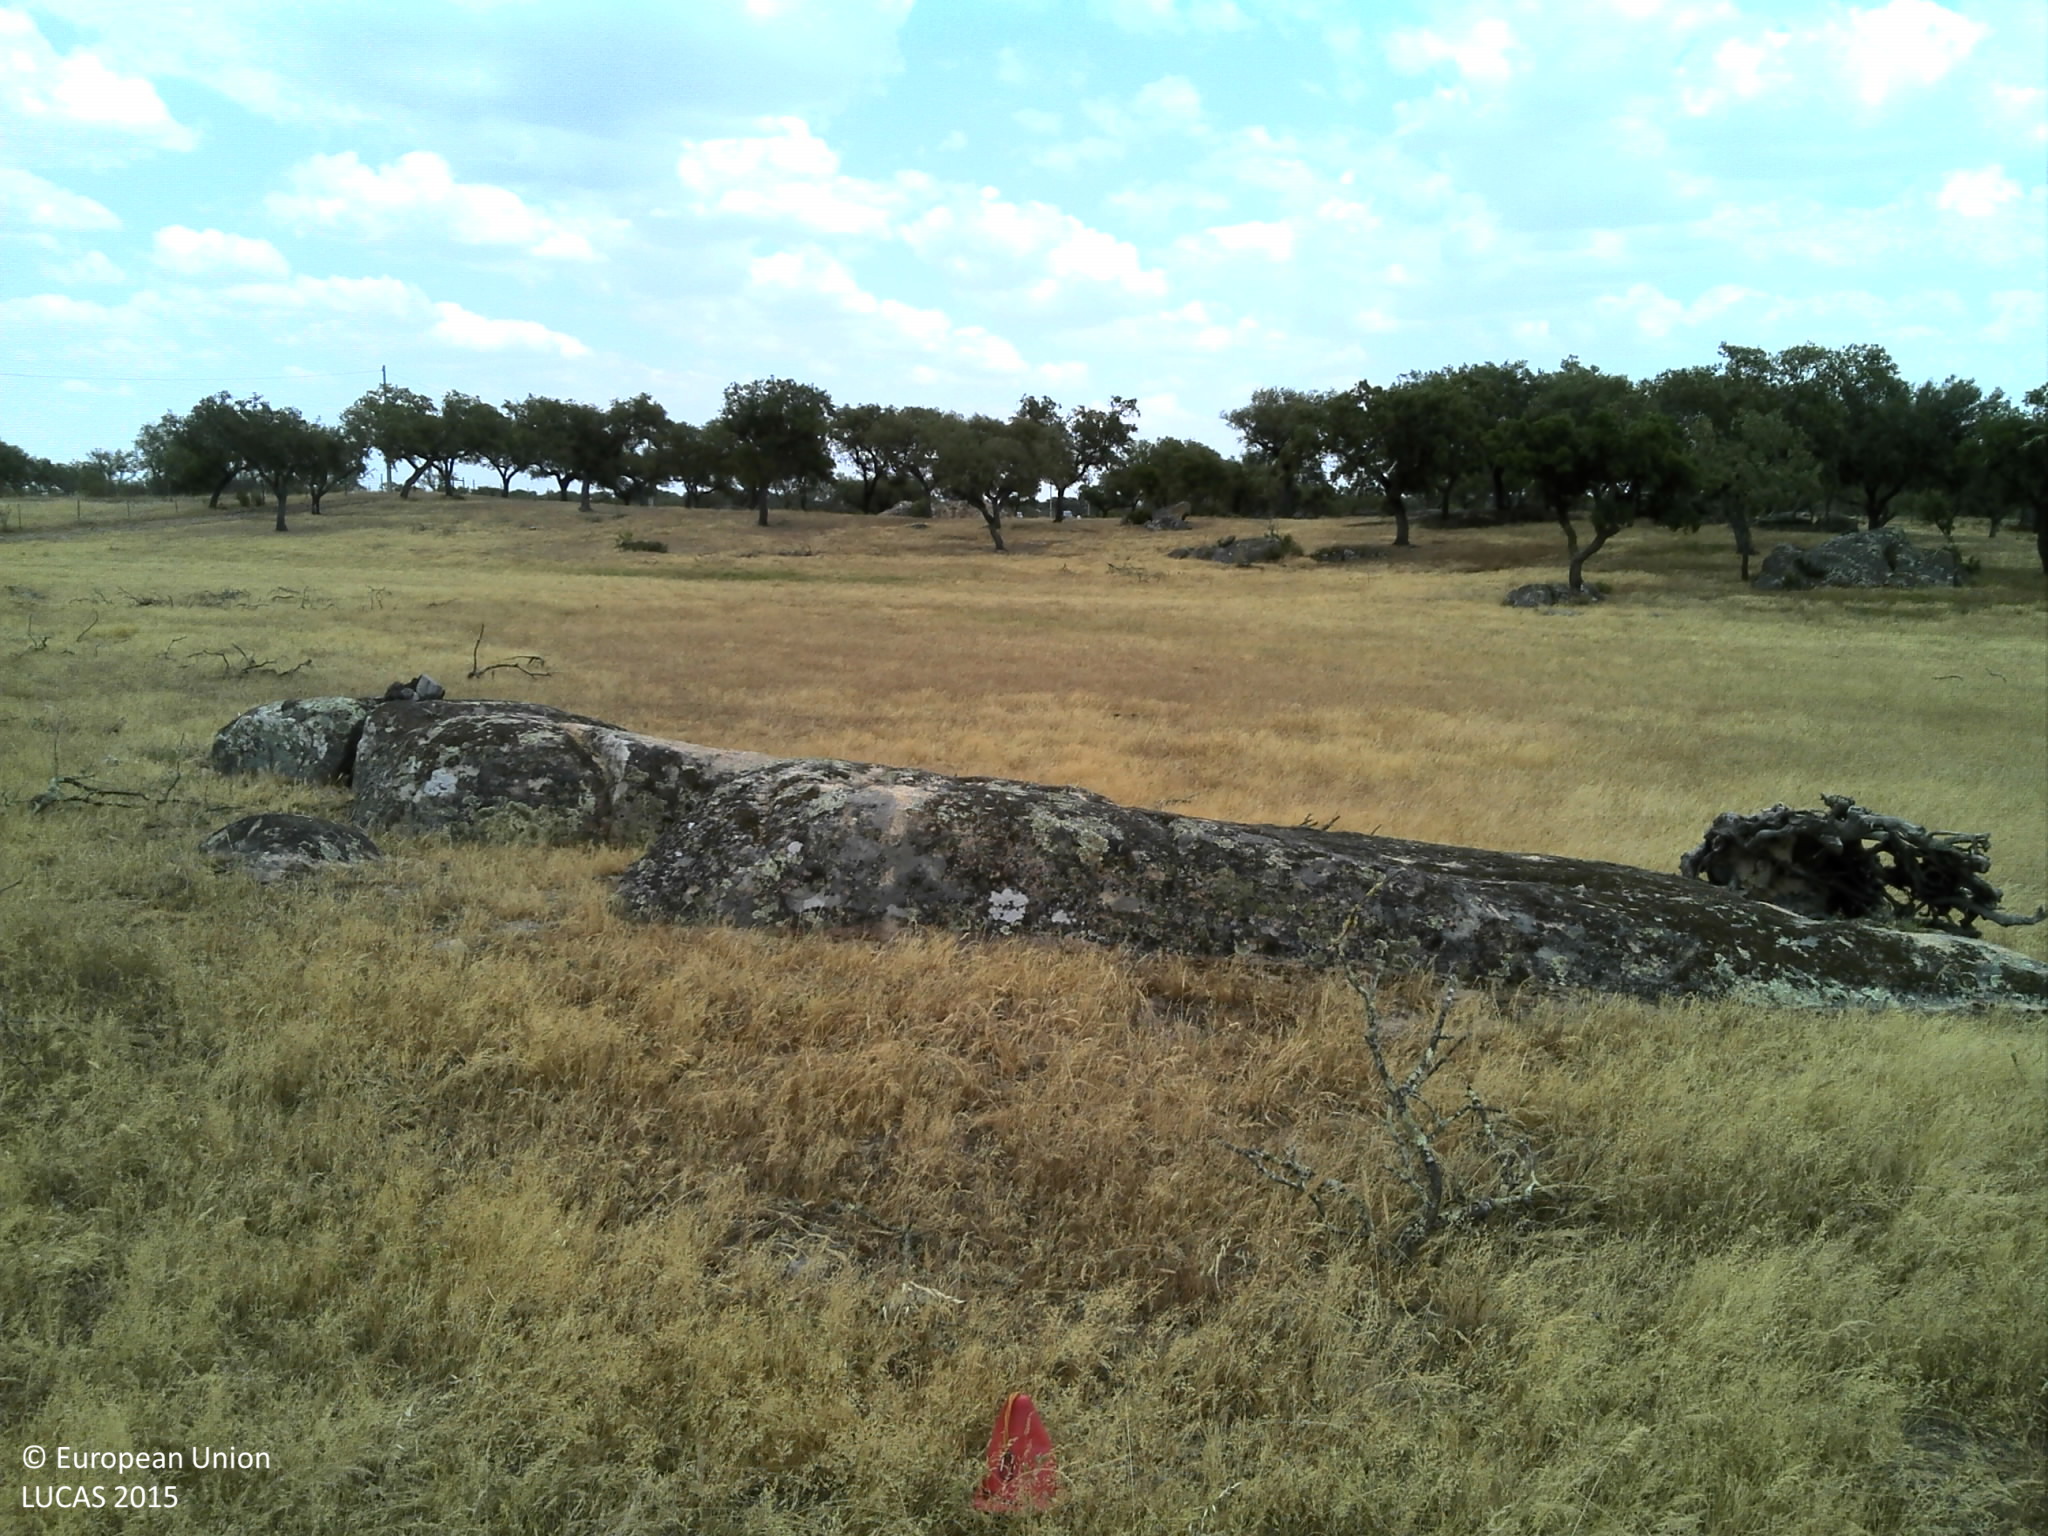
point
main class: Woodland
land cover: Broadleaved woodland
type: broadleaved evergreen forest
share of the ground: 10 - 25 %
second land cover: Grassland without tree/shrub cover
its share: 25 - 50 %
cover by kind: herbaceous plants 50 %, broadleaved forest trees 25 %, unconsolidated bare surface 25 %
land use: Forestry
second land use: Agriculture (excluding fallow land and kitchen gardens)
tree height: > 5 m
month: May
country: PT
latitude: 38.8477
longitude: -7.8920
